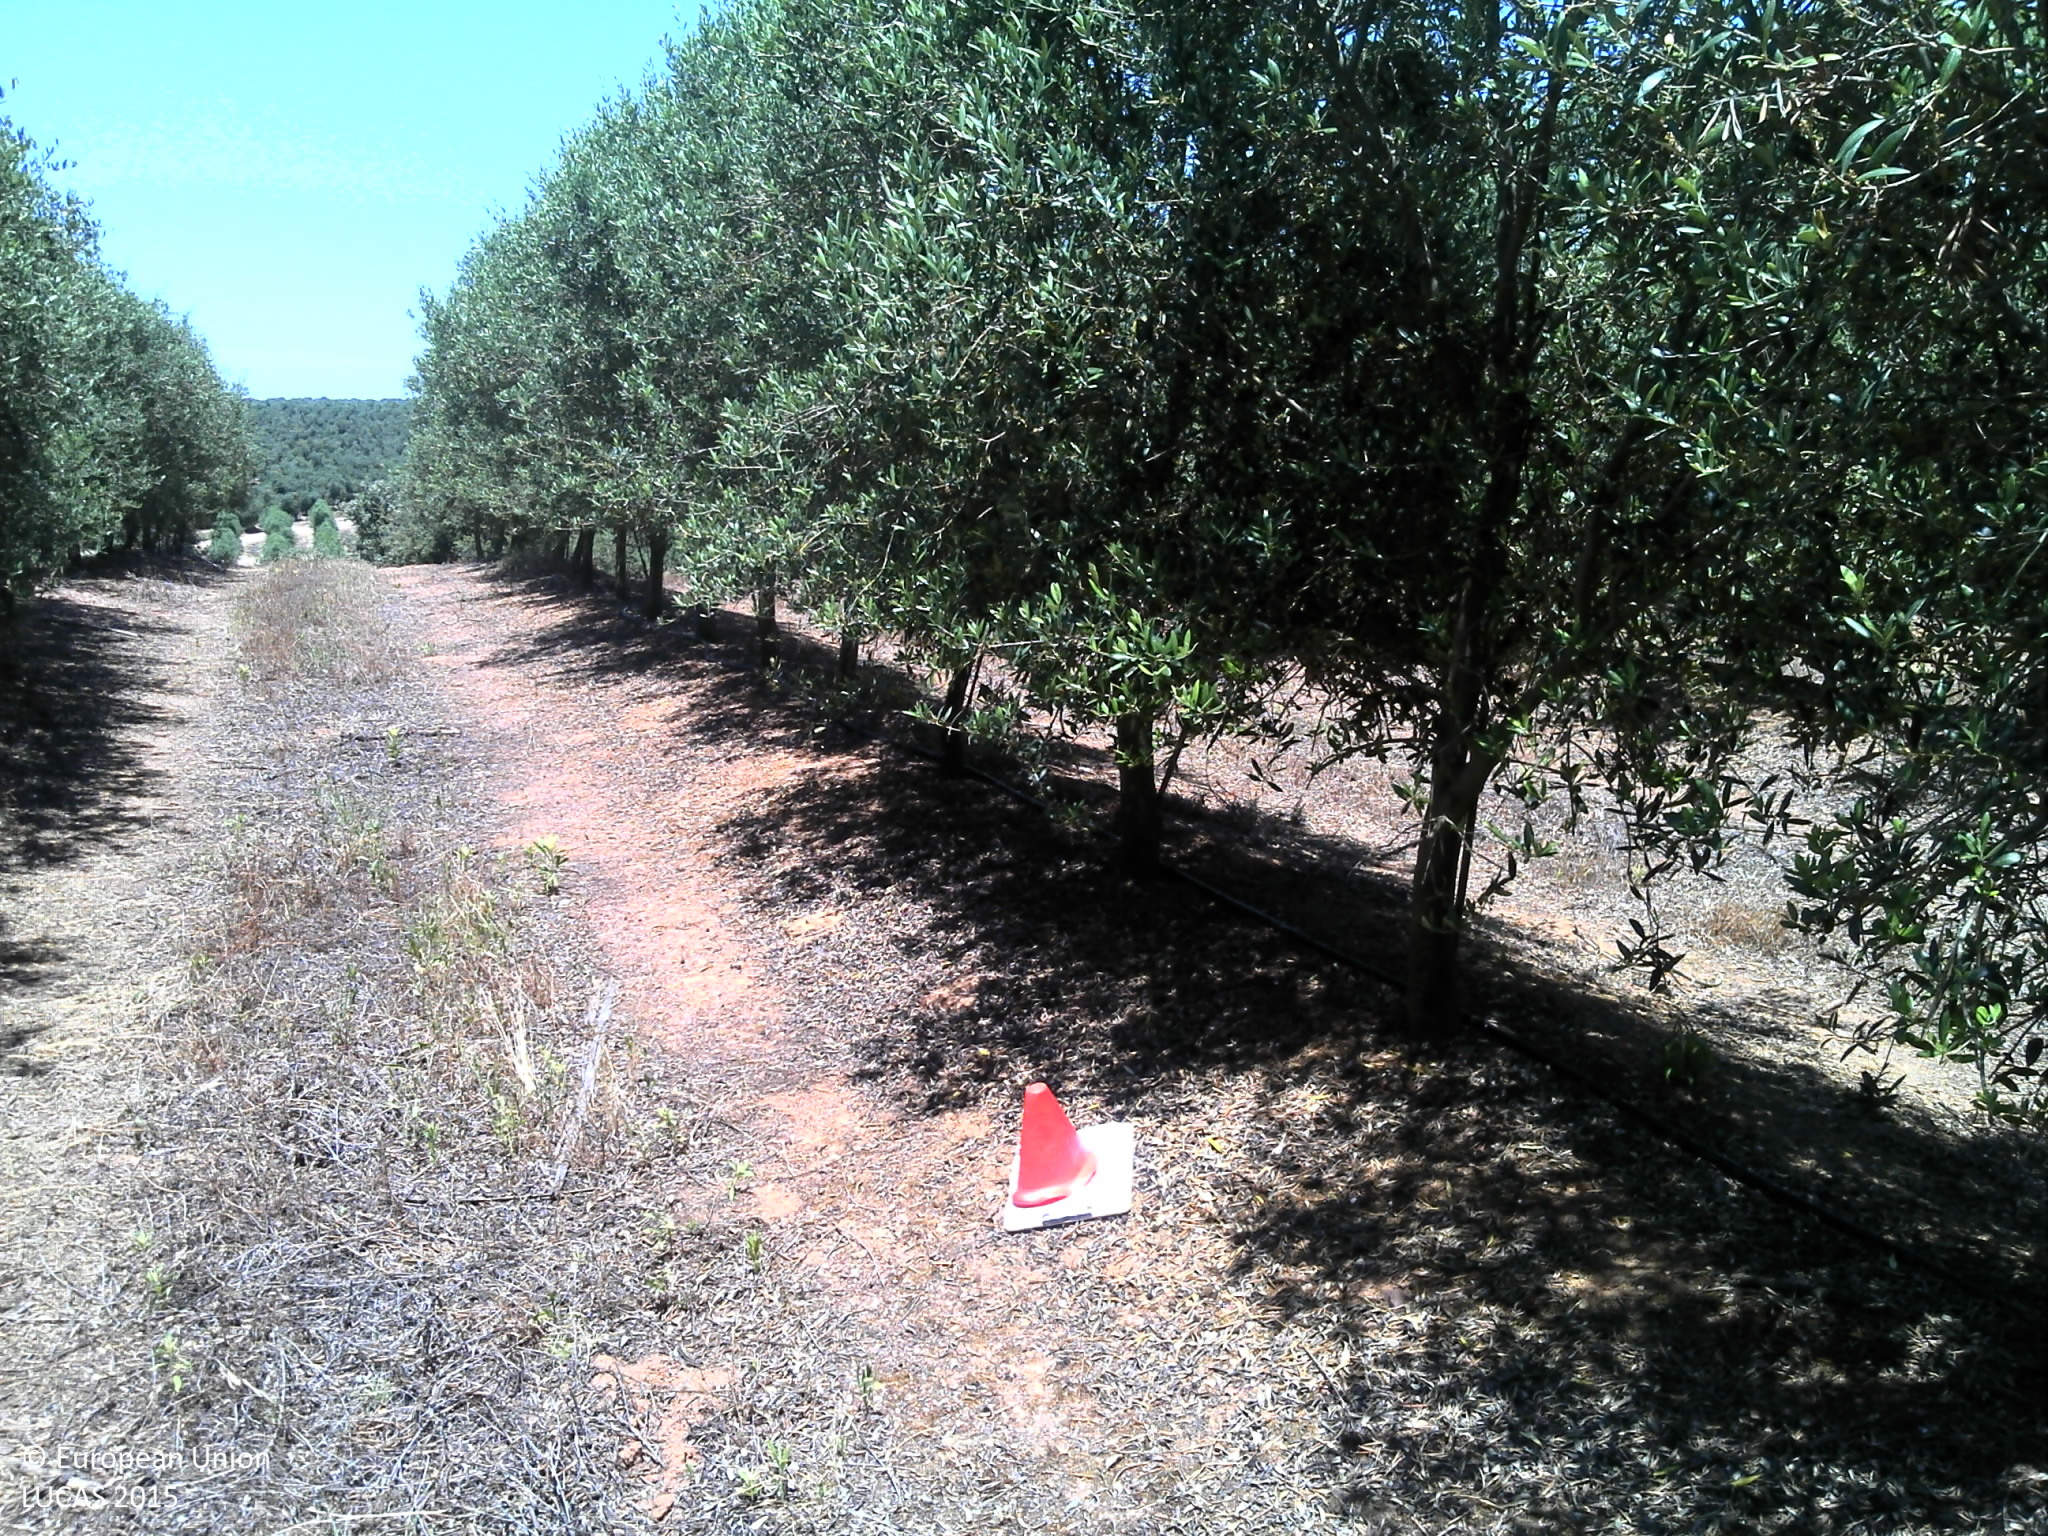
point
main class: Cropland
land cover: Olive groves
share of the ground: 25 - 50 %
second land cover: Grassland without tree/shrub cover
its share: 50 - 75 %
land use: Agriculture (excluding fallow land and kitchen gardens)
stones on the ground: < 10 %
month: June
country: PT
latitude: 37.9551
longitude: -8.3036
